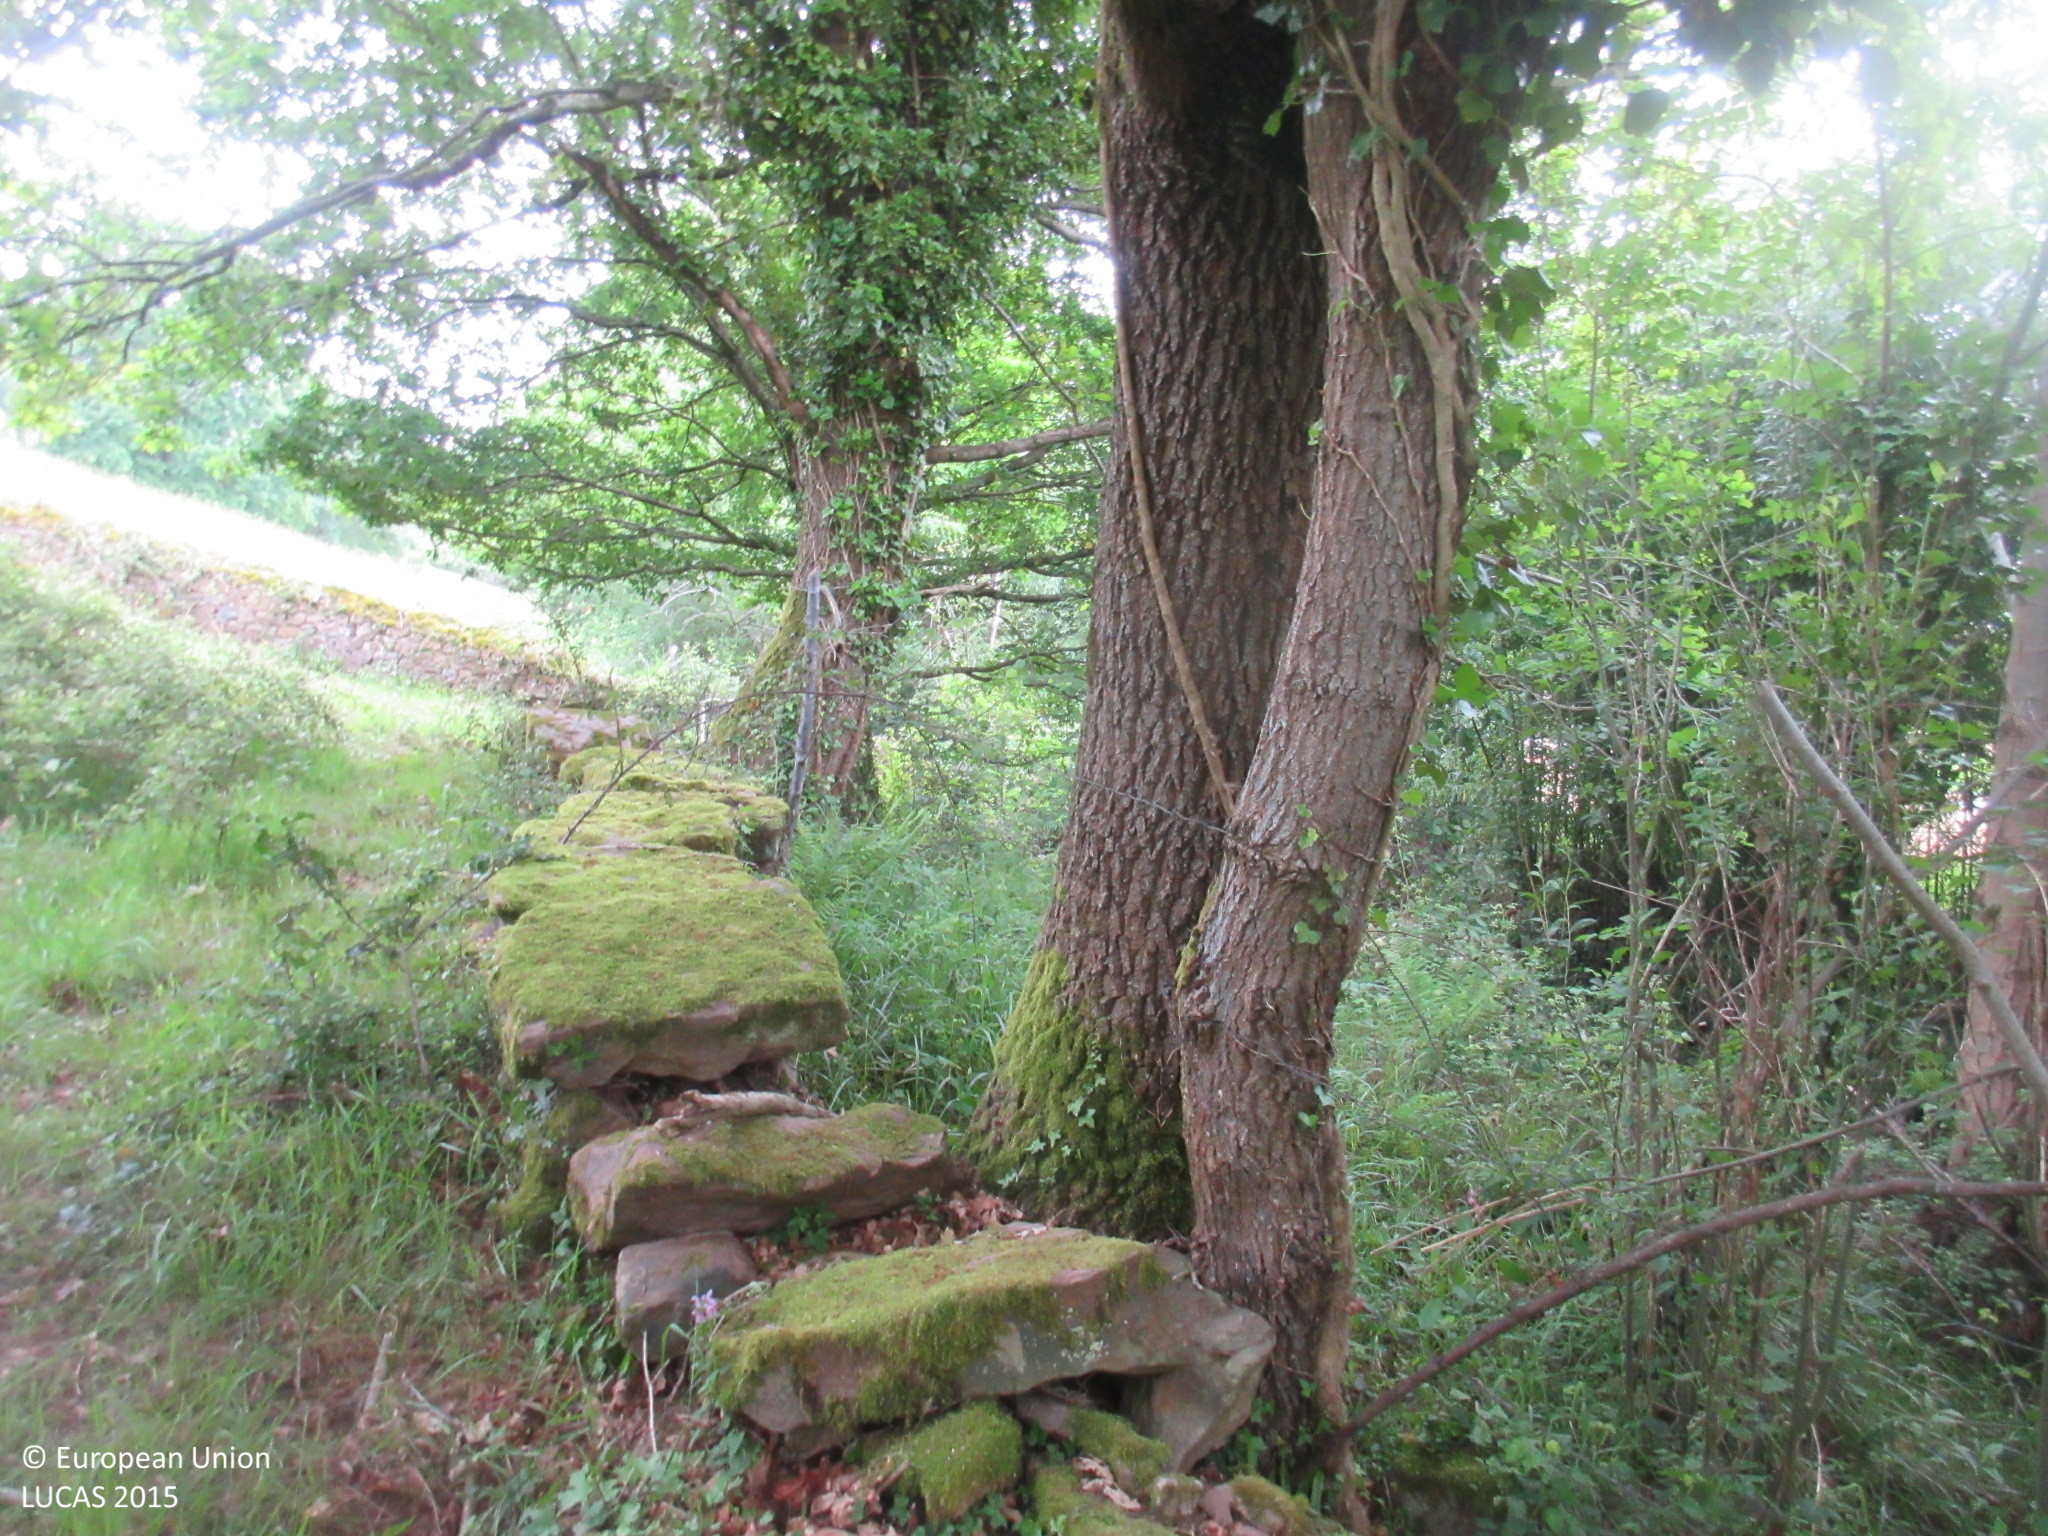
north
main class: Shrubland
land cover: Shrubland with sparse tree cover
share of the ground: 50 - 75 %
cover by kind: shrubs 65 %, herbaceous plants 30 %, broadleaved forest trees 5 %
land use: Agriculture (excluding fallow land and kitchen gardens)
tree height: > 5 m
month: May
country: ES
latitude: 43.2893
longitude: -4.2406
